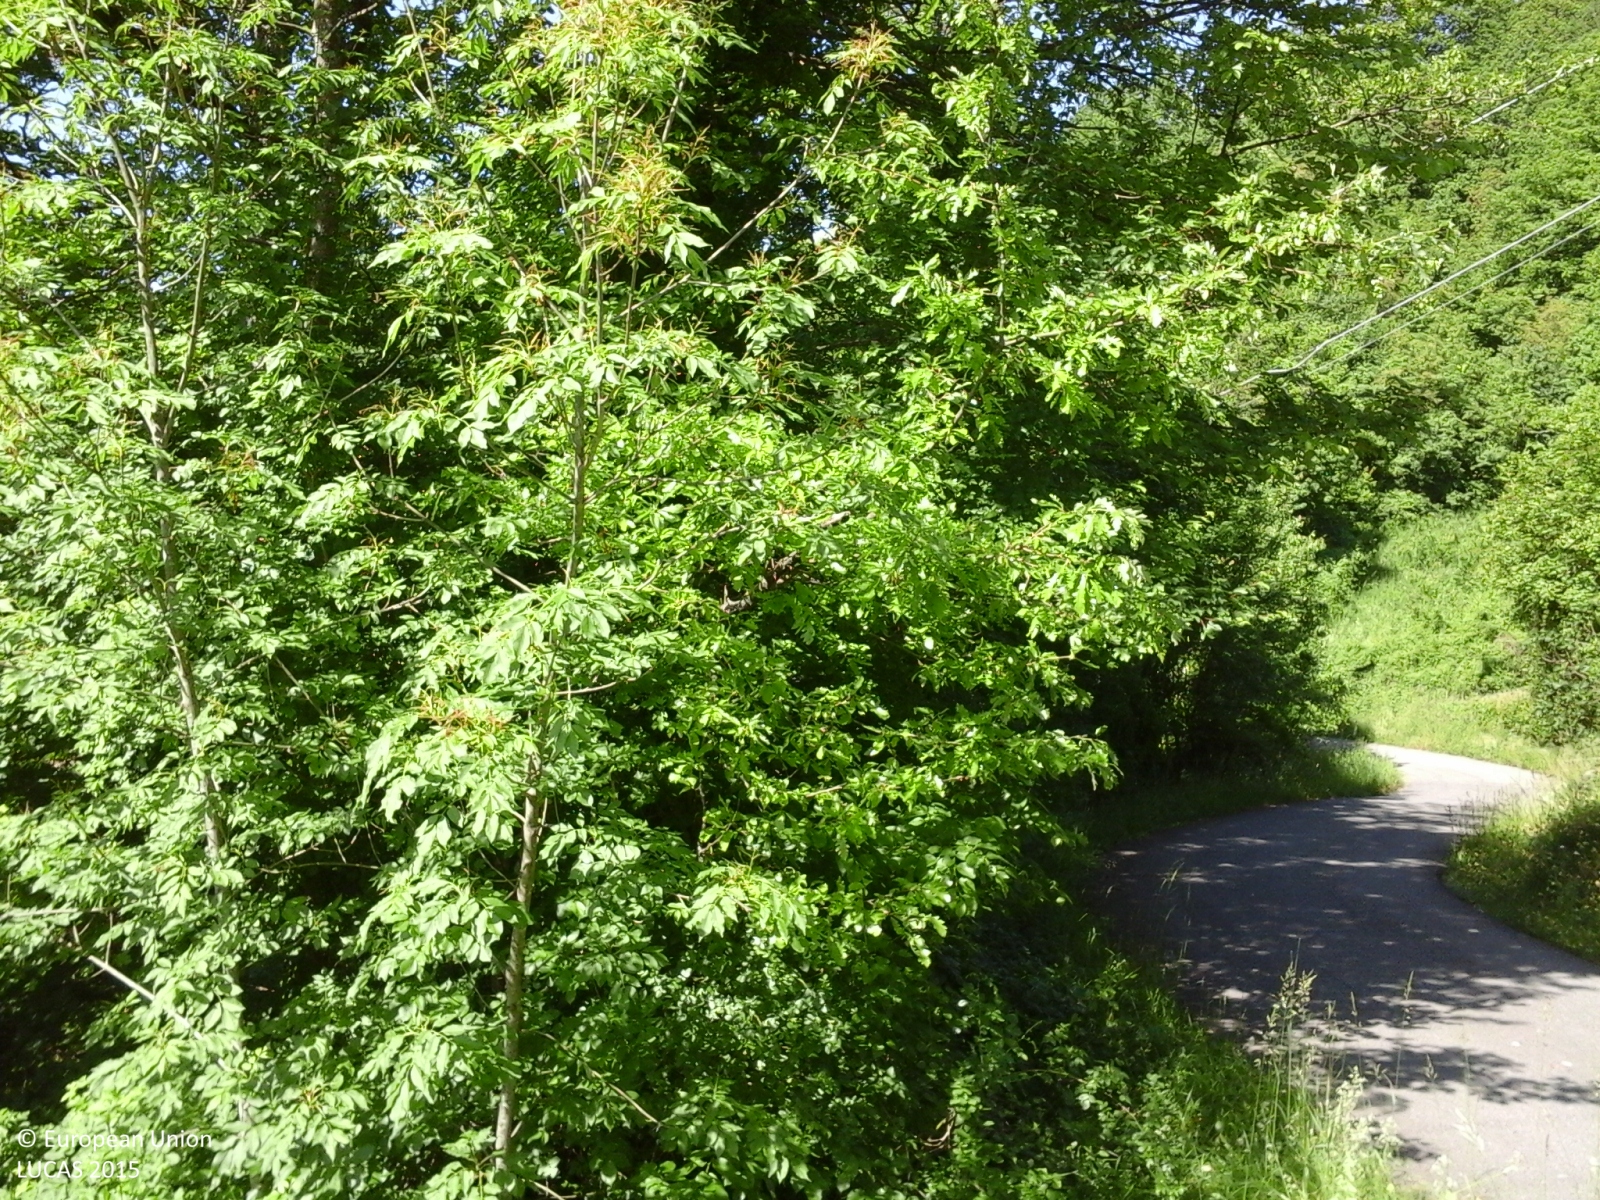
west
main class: Woodland
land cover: Broadleaved woodland
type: thermophilous deciduous forest
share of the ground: > 75 %
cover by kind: broadleaved forest trees 95 %, shrubs 5 %
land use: Forestry
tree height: > 5 m
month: May
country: IT
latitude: 44.5121
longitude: 9.6109
